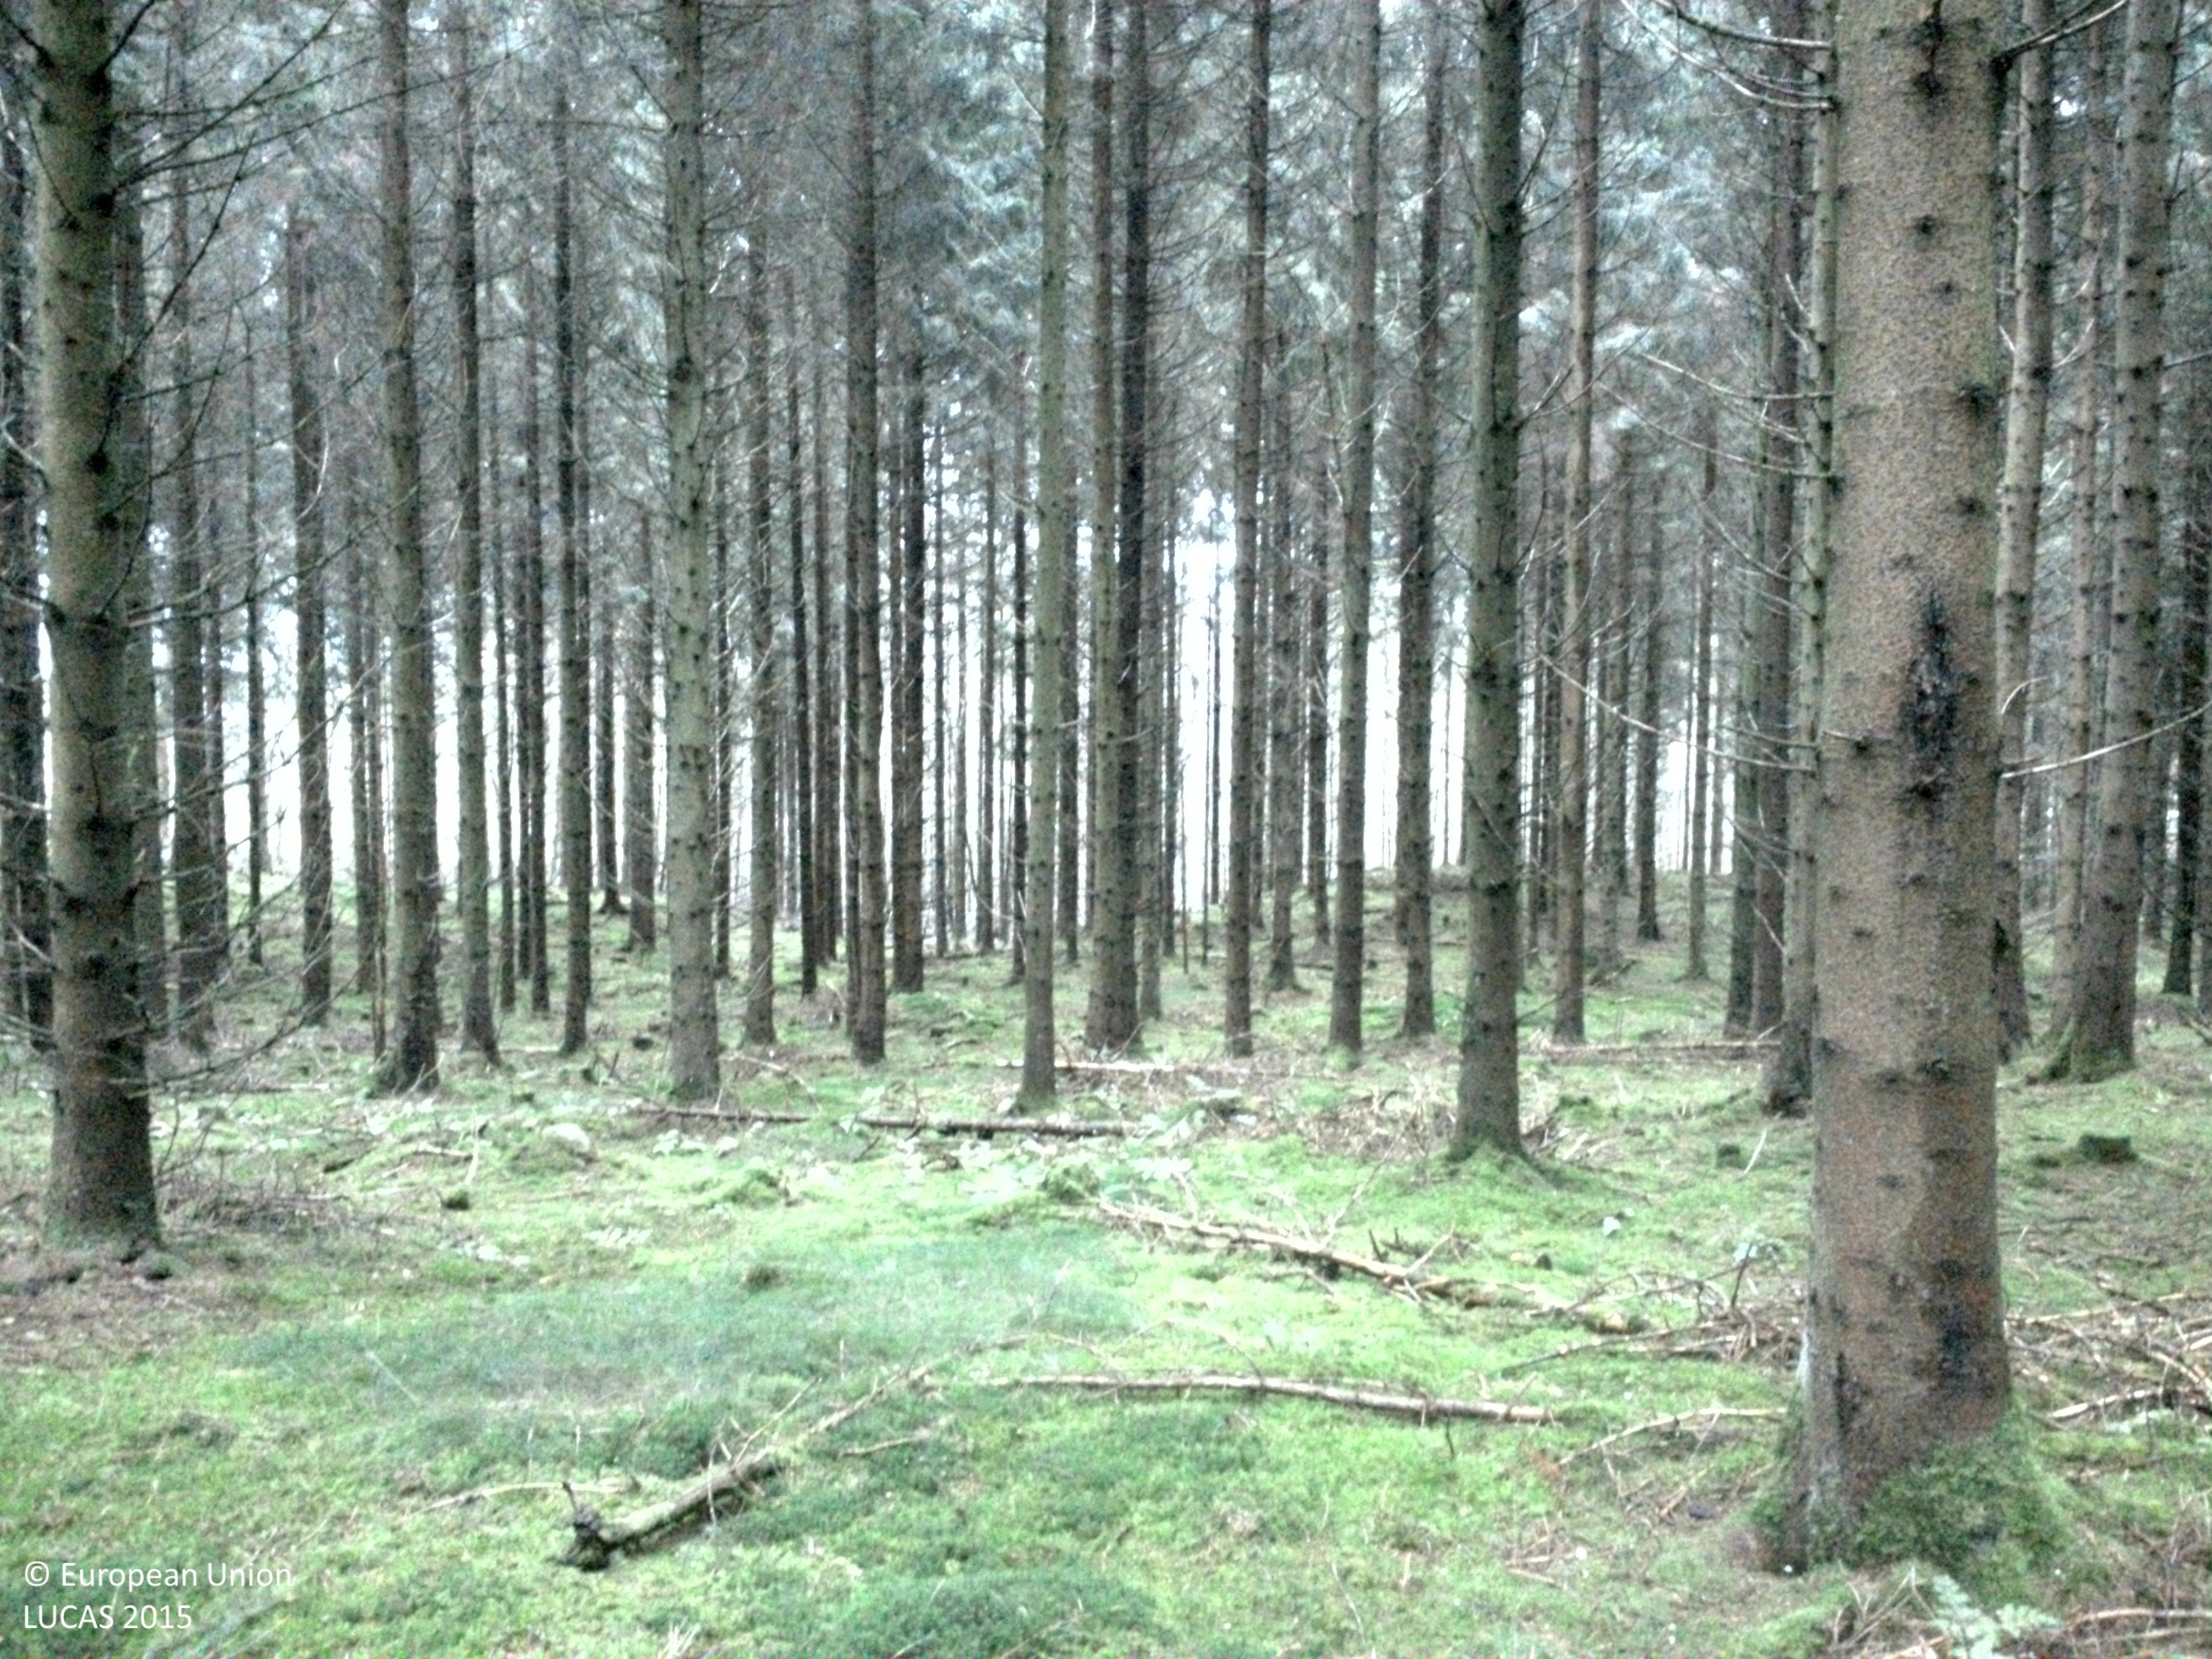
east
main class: Woodland
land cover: Spruce dominated coniferous woodland
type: hemiboreal forest and nemoral coniferous forest and mixed broadleaved-coniferous forest
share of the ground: > 75 %
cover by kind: coniferous forest trees 85 %, lichens and mosses 10 %, herbaceous plants 5 %
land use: Forestry
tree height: > 5 m
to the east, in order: Spruce dominated coniferous woodland; Broadleaved woodland; Grassland without tree/shrub cover; Managed hedges; Artificial constructions in urban areas
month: November
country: SE
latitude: 56.2385
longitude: 13.1758
